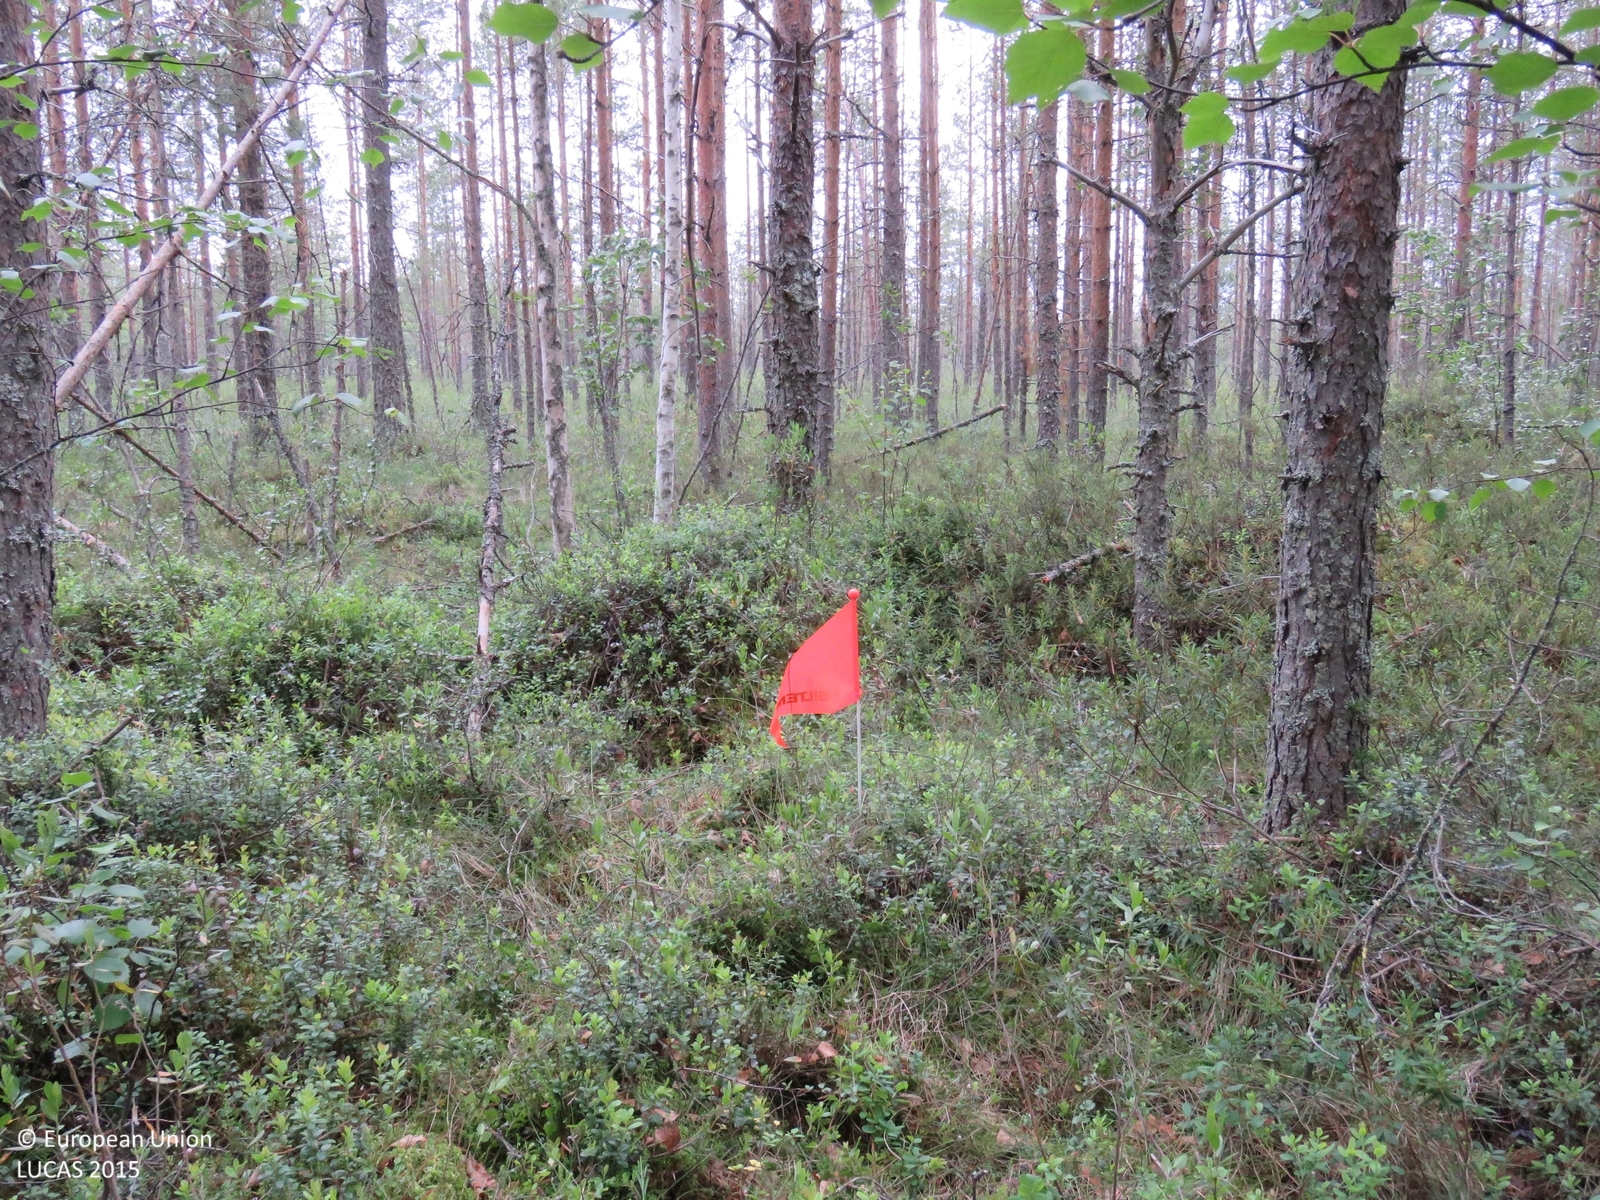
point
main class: Woodland
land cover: Pine dominated coniferous woodland
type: mire and swamp forests
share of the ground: > 75 %
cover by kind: coniferous forest trees 70 %, broadleaved forest trees 20 %, shrubs 10 %
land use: Forestry
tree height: > 5 m
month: July
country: FI
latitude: 64.2814
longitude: 26.5380
